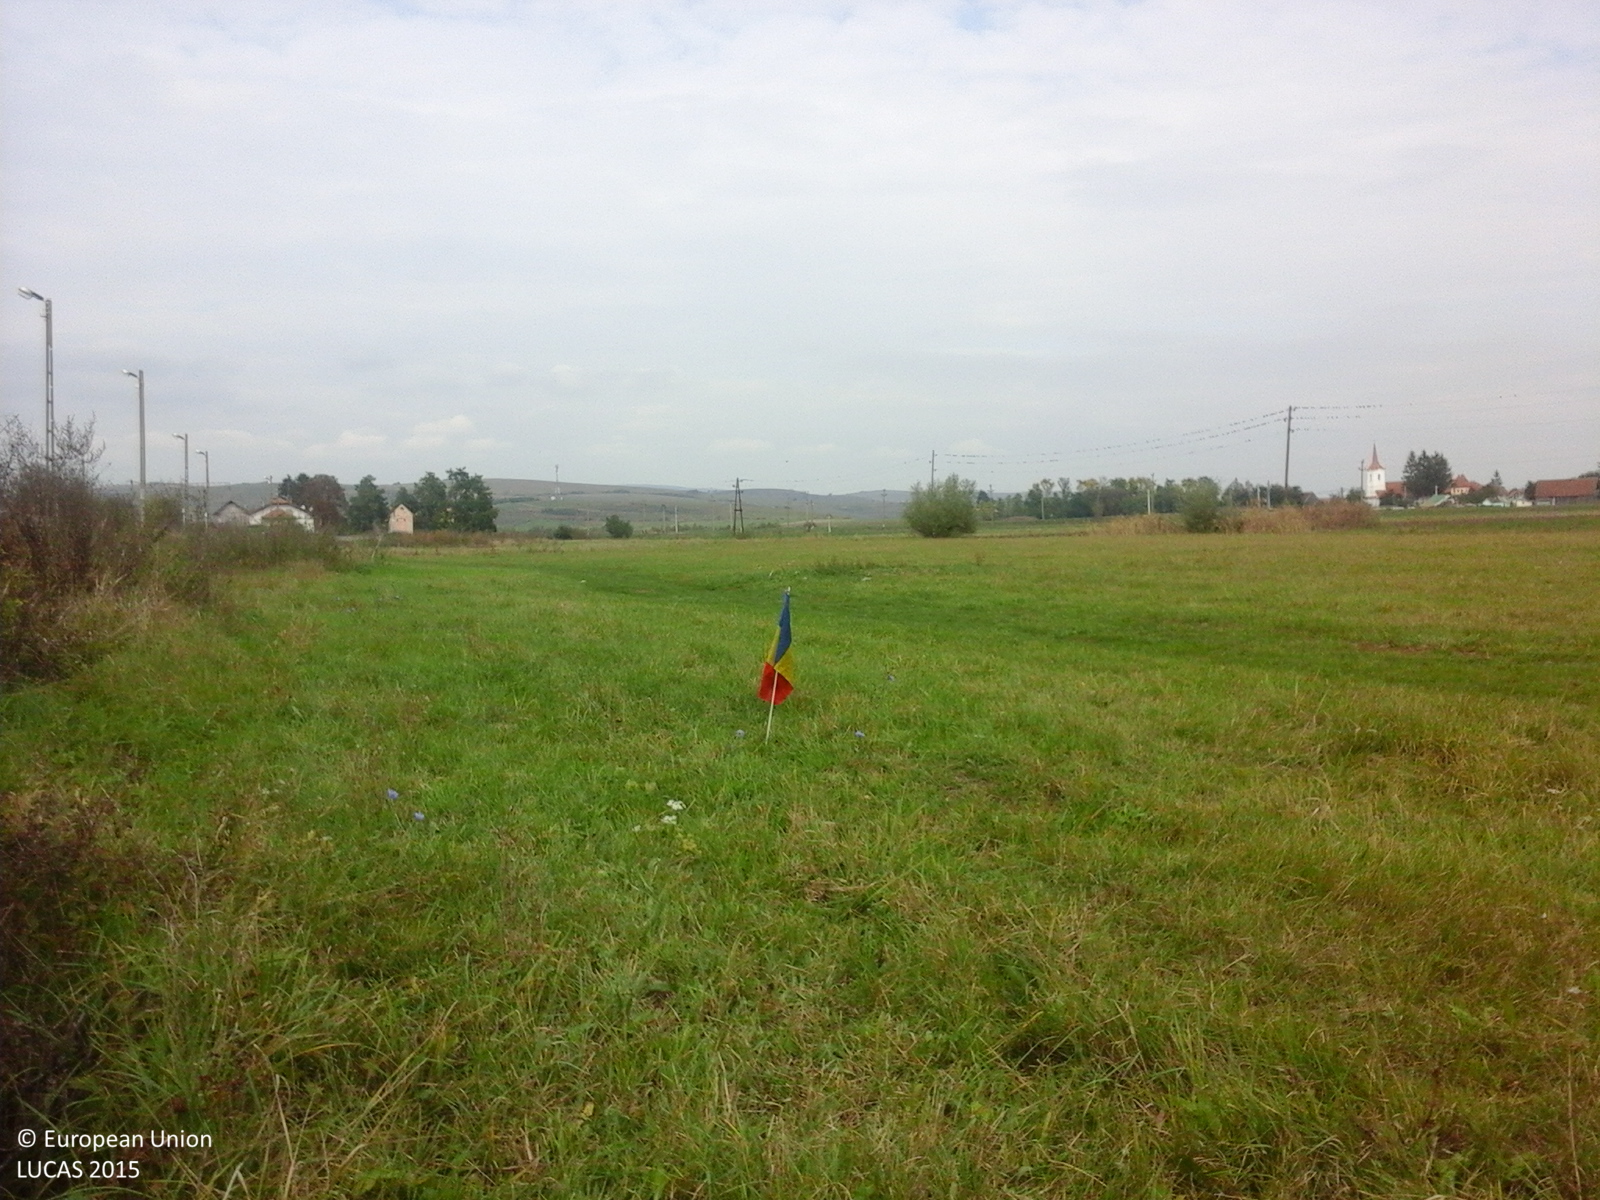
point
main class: Grassland
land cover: Grassland without tree/shrub cover
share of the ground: > 75 %
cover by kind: herbaceous plants 100 %
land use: Agriculture (excluding fallow land and kitchen gardens)
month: October
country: RO
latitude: 46.0892
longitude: 25.2711
